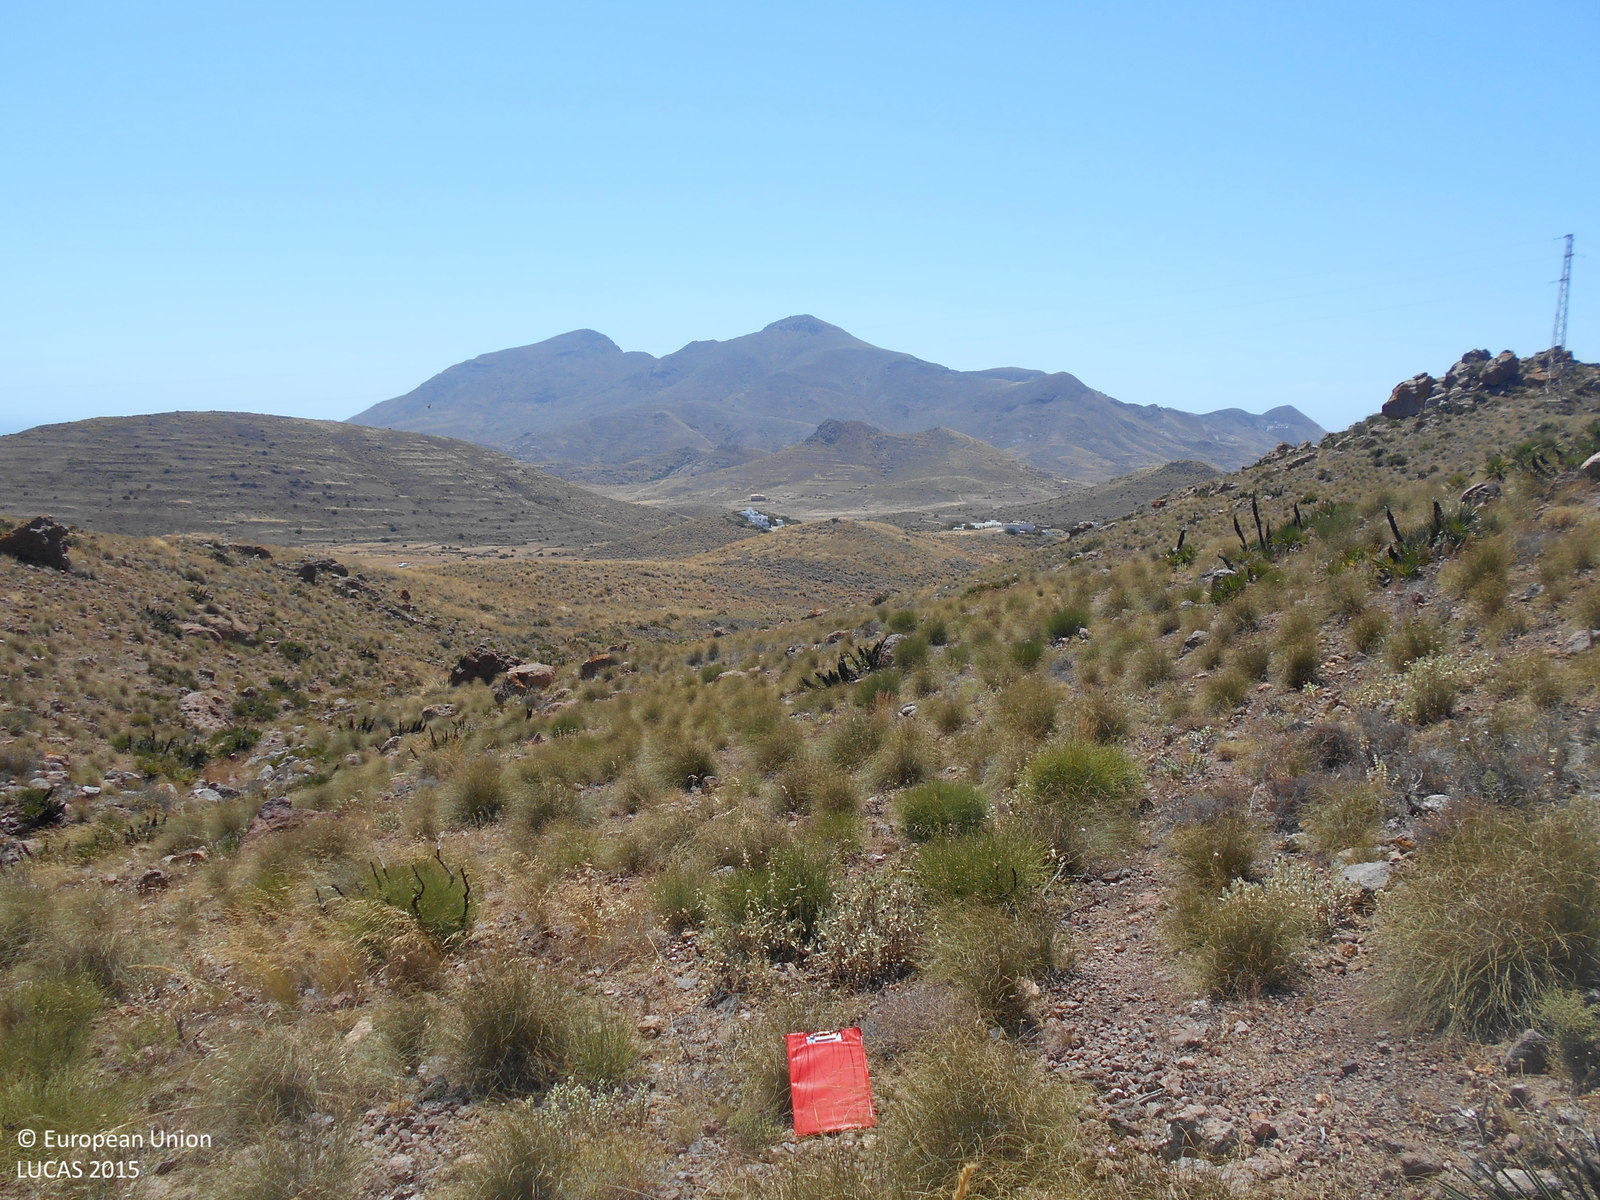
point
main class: Shrubland
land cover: Shrubland without tree cover
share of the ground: 25 - 50 %
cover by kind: shrubs 30 %, consolidated bare surface 30 %, unconsolidated bare surface 30 %, herbaceous plants 10 %
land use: Semi-natural and natural areas not in use
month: May
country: ES
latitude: 36.8054
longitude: -2.1115
